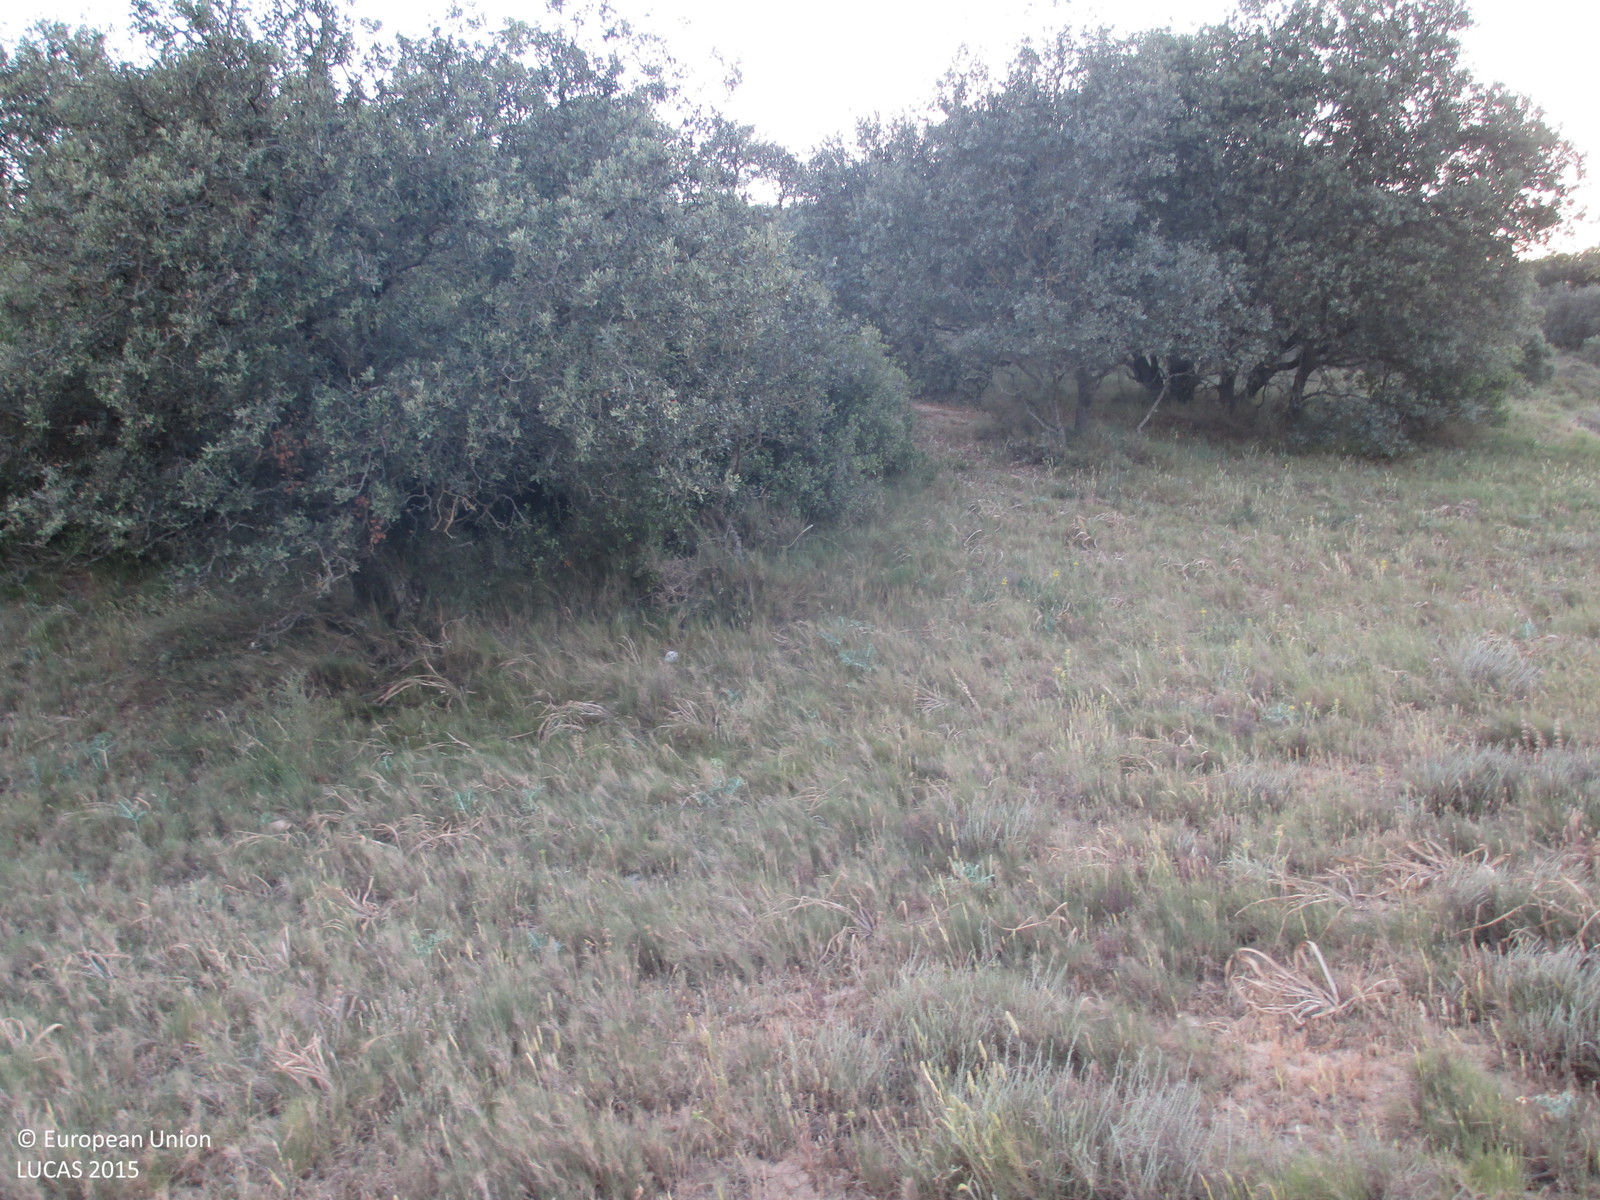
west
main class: Shrubland
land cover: Shrubland with sparse tree cover
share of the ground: > 75 %
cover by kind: shrubs 90 %, broadleaved forest trees 5 %, herbaceous plants 5 %
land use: Semi-natural and natural areas not in use
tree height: < 5 m
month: May
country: ES
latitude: 41.9748
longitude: -0.1931
